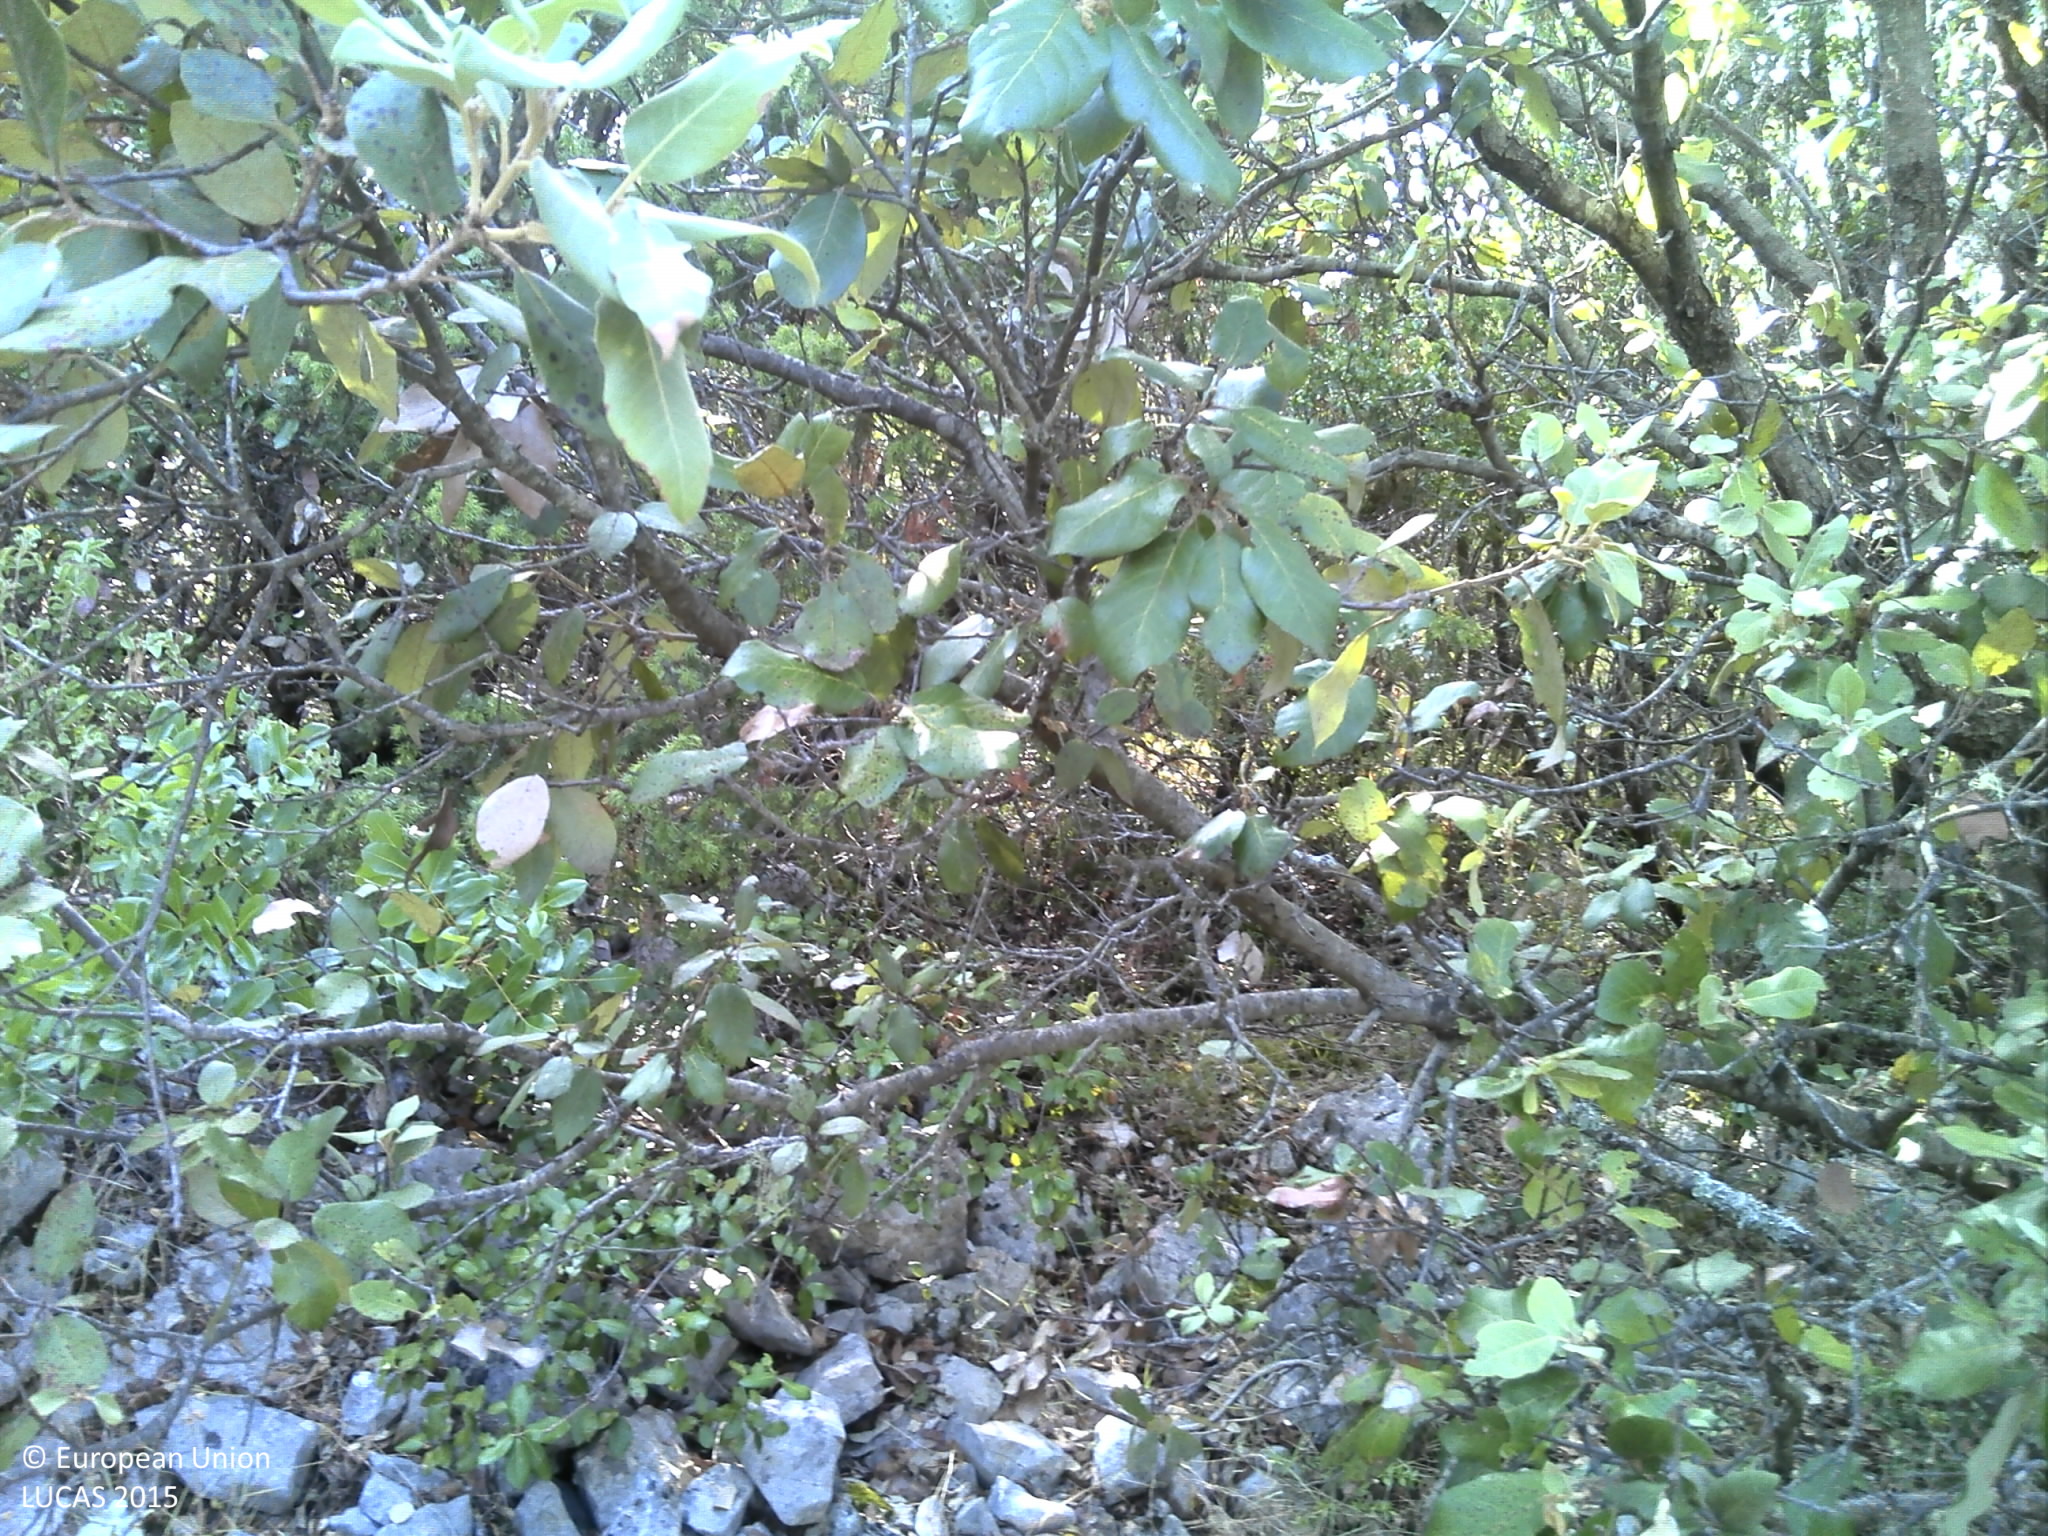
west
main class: Shrubland
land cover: Shrubland with sparse tree cover
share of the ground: > 75 %
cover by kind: shrubs 75 %, broadleaved forest trees 5 %, herbaceous plants 5 %, lichens and mosses 5 %, consolidated bare surface 5 %, unconsolidated bare surface 5 %
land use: Semi-natural and natural areas not in use
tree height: < 5 m
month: August
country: HR
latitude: 43.1390
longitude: 16.9609
